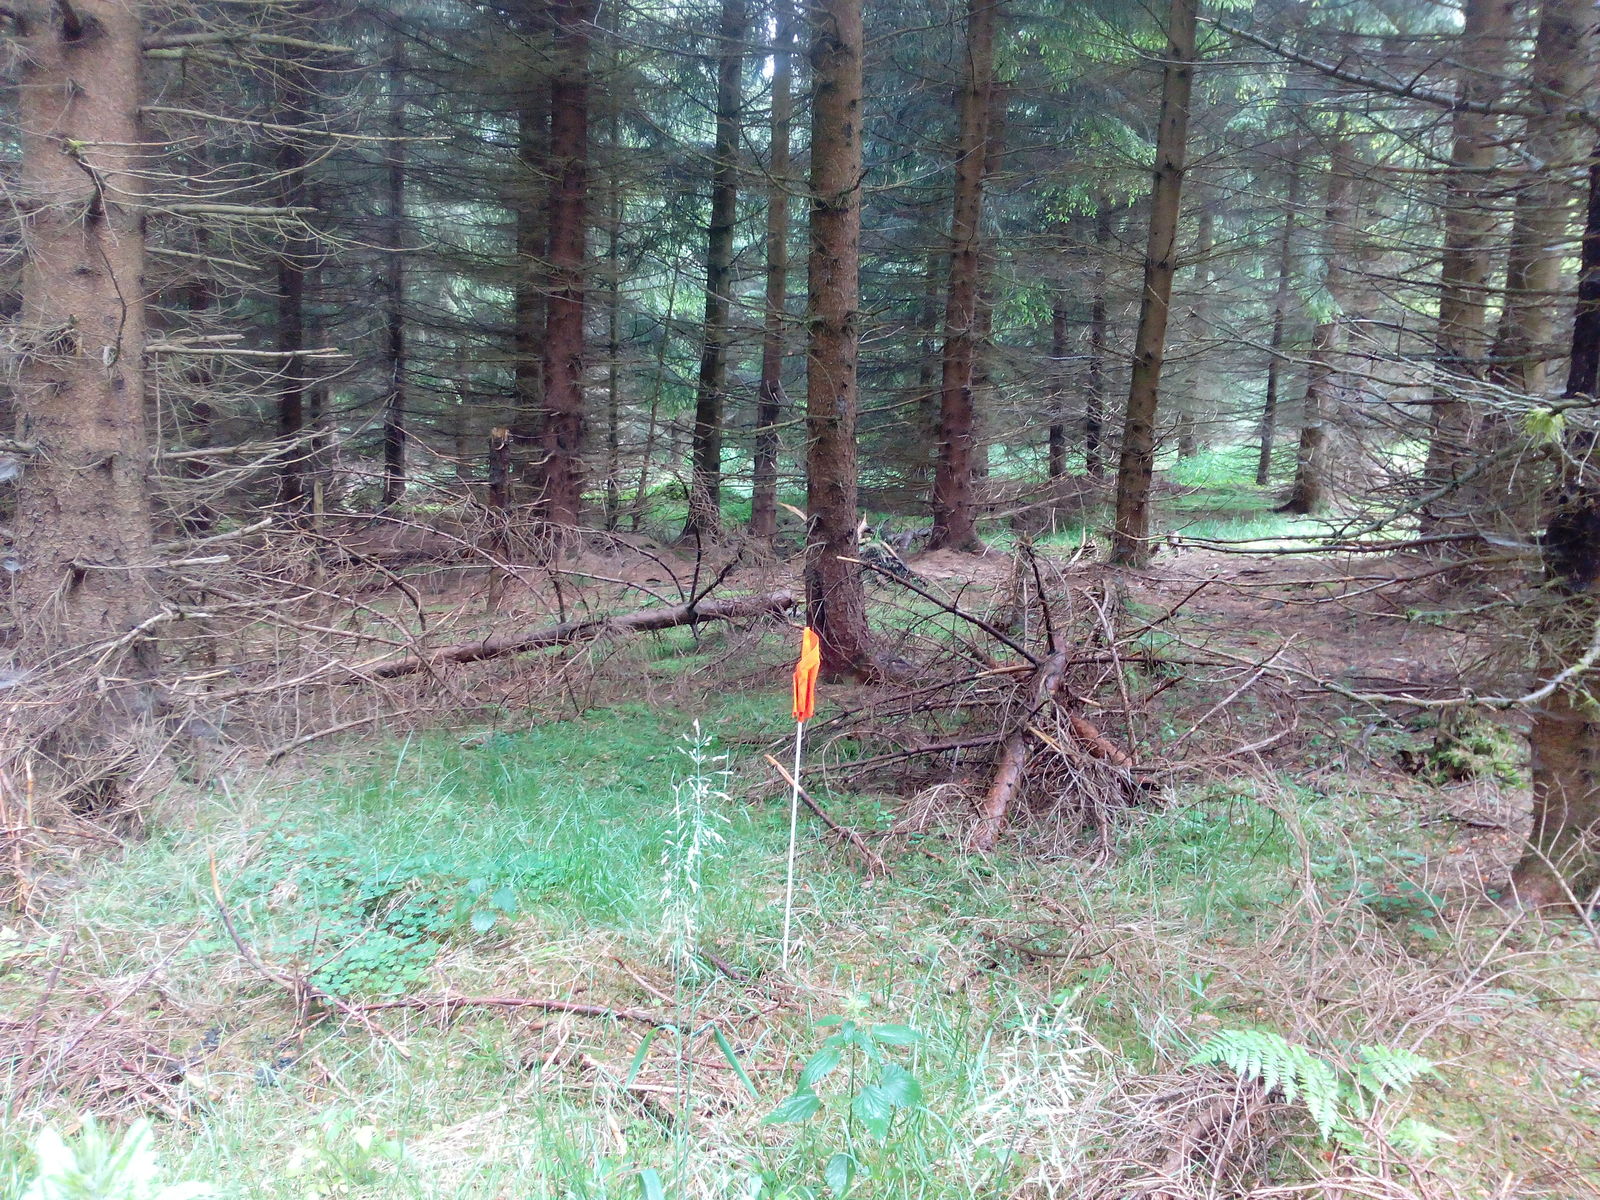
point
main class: Woodland
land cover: Spruce dominated coniferous woodland
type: hemiboreal forest and nemoral coniferous forest and mixed broadleaved-coniferous forest
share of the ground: 50 - 75 %
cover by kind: coniferous forest trees 70 %, herbaceous plants 30 %
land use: Forestry
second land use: Amenities, museums, leisure
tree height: > 5 m
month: June
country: DE
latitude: 50.5400
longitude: 10.9451
